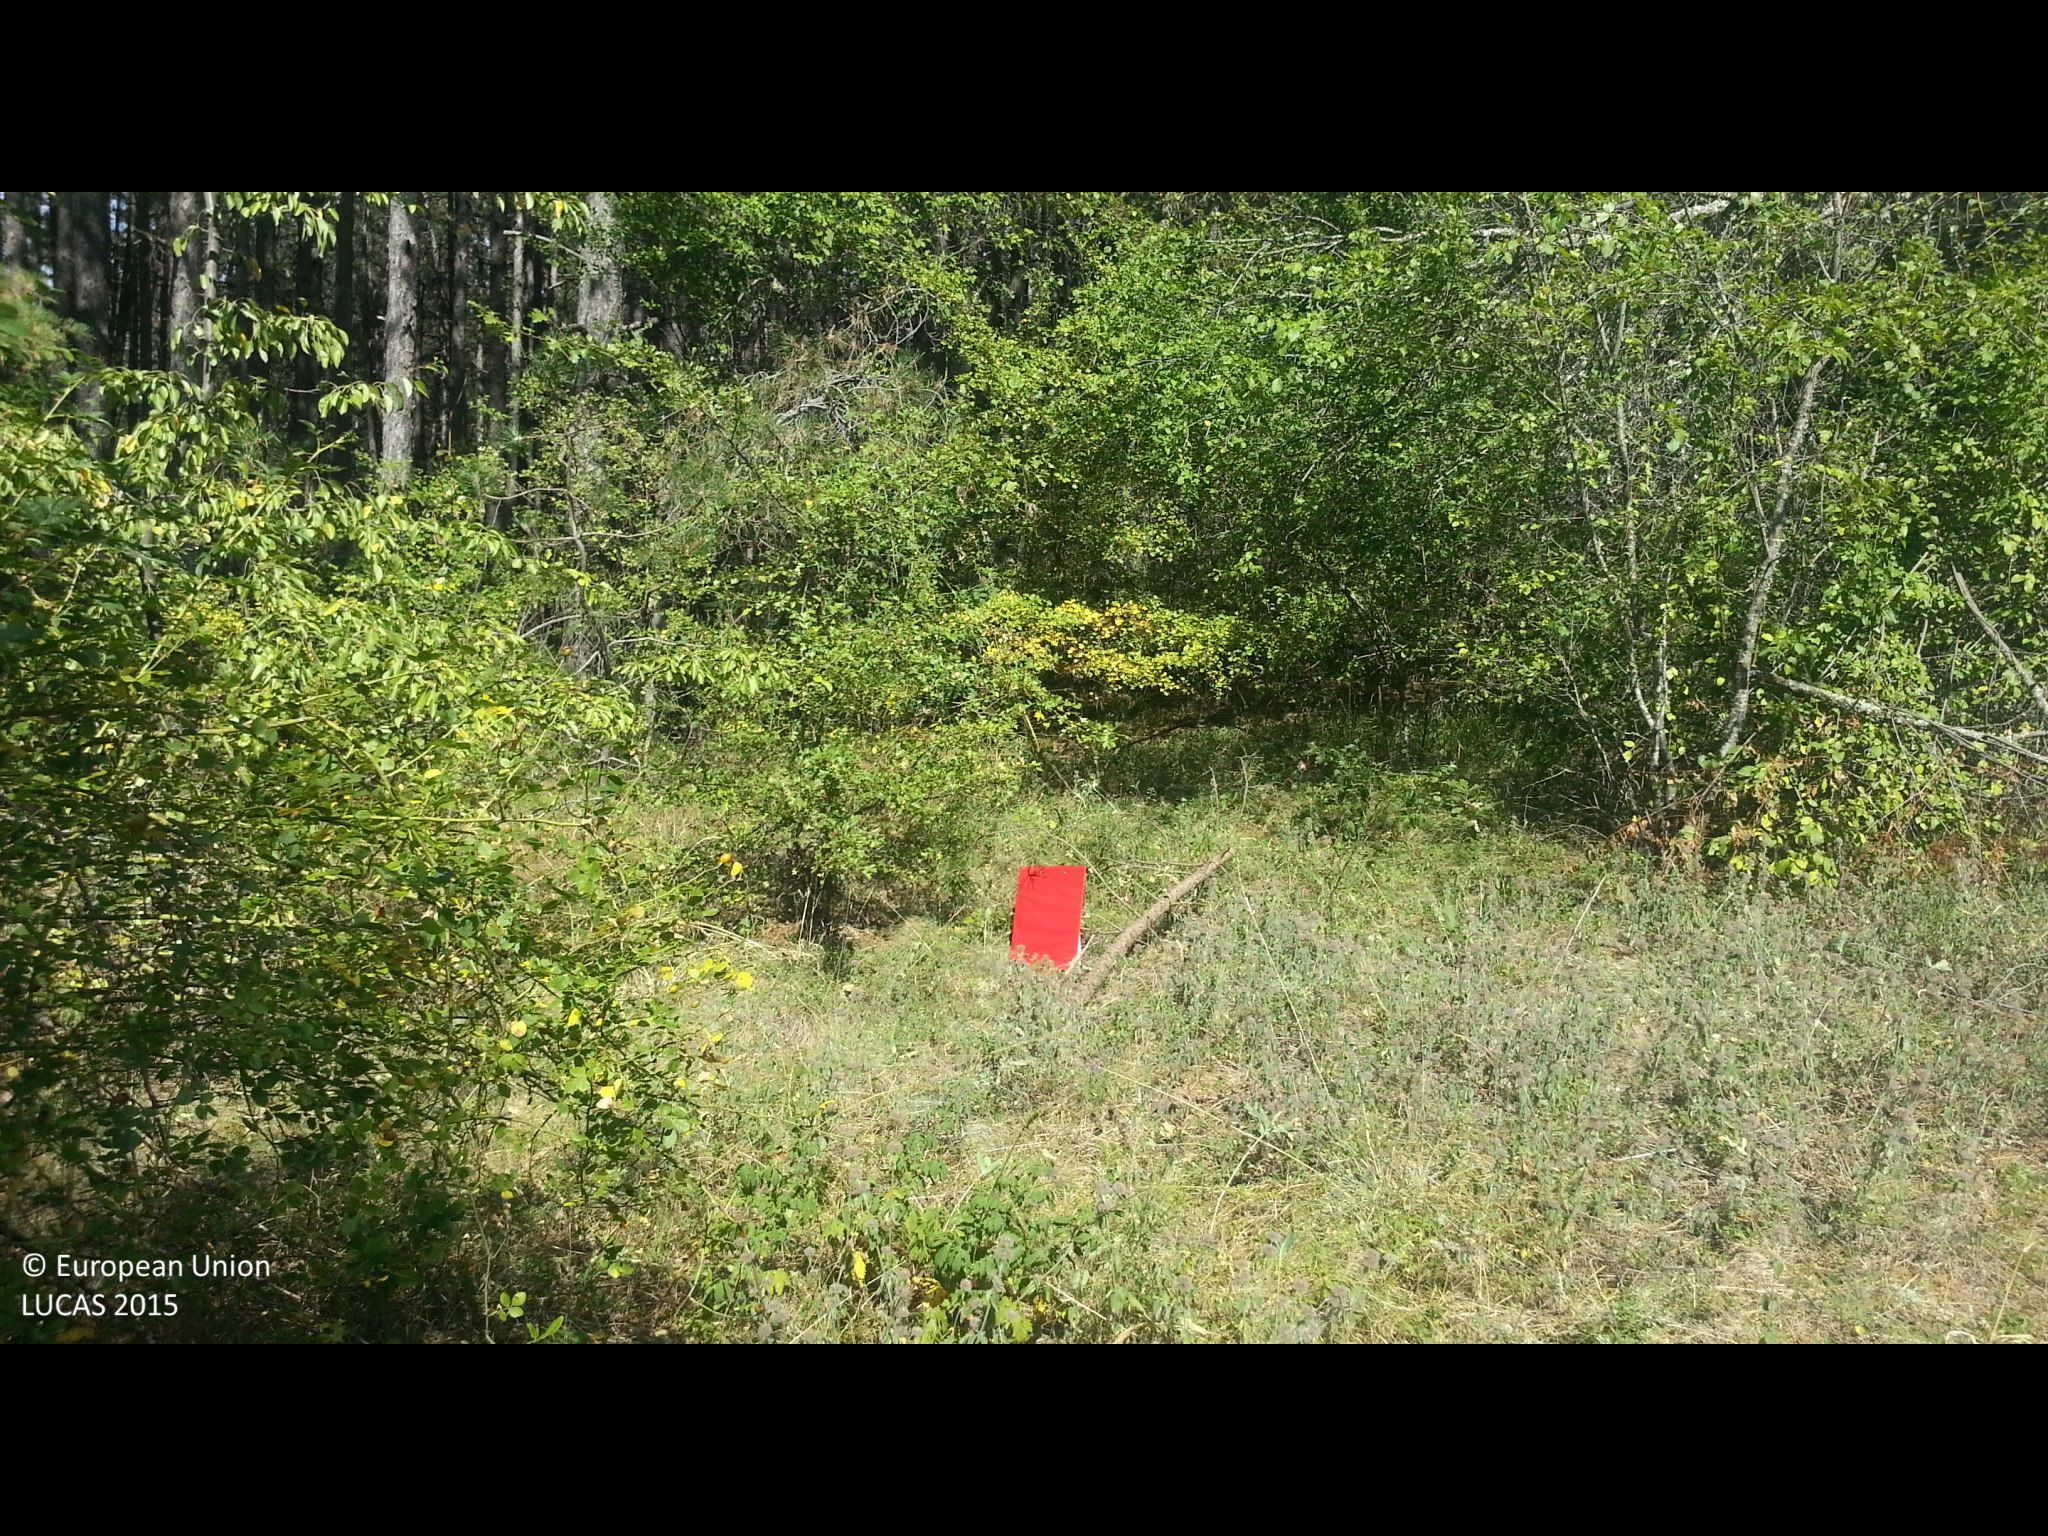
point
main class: Woodland
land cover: Pine dominated mixed woodland
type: hemiboreal forest and nemoral coniferous forest and mixed broadleaved-coniferous forest
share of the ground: > 75 %
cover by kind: coniferous forest trees 65 %, broadleaved forest trees 25 %, herbaceous plants 10 %
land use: Forestry
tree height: < 5 m
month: September
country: BG
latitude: 42.4294
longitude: 22.6023
